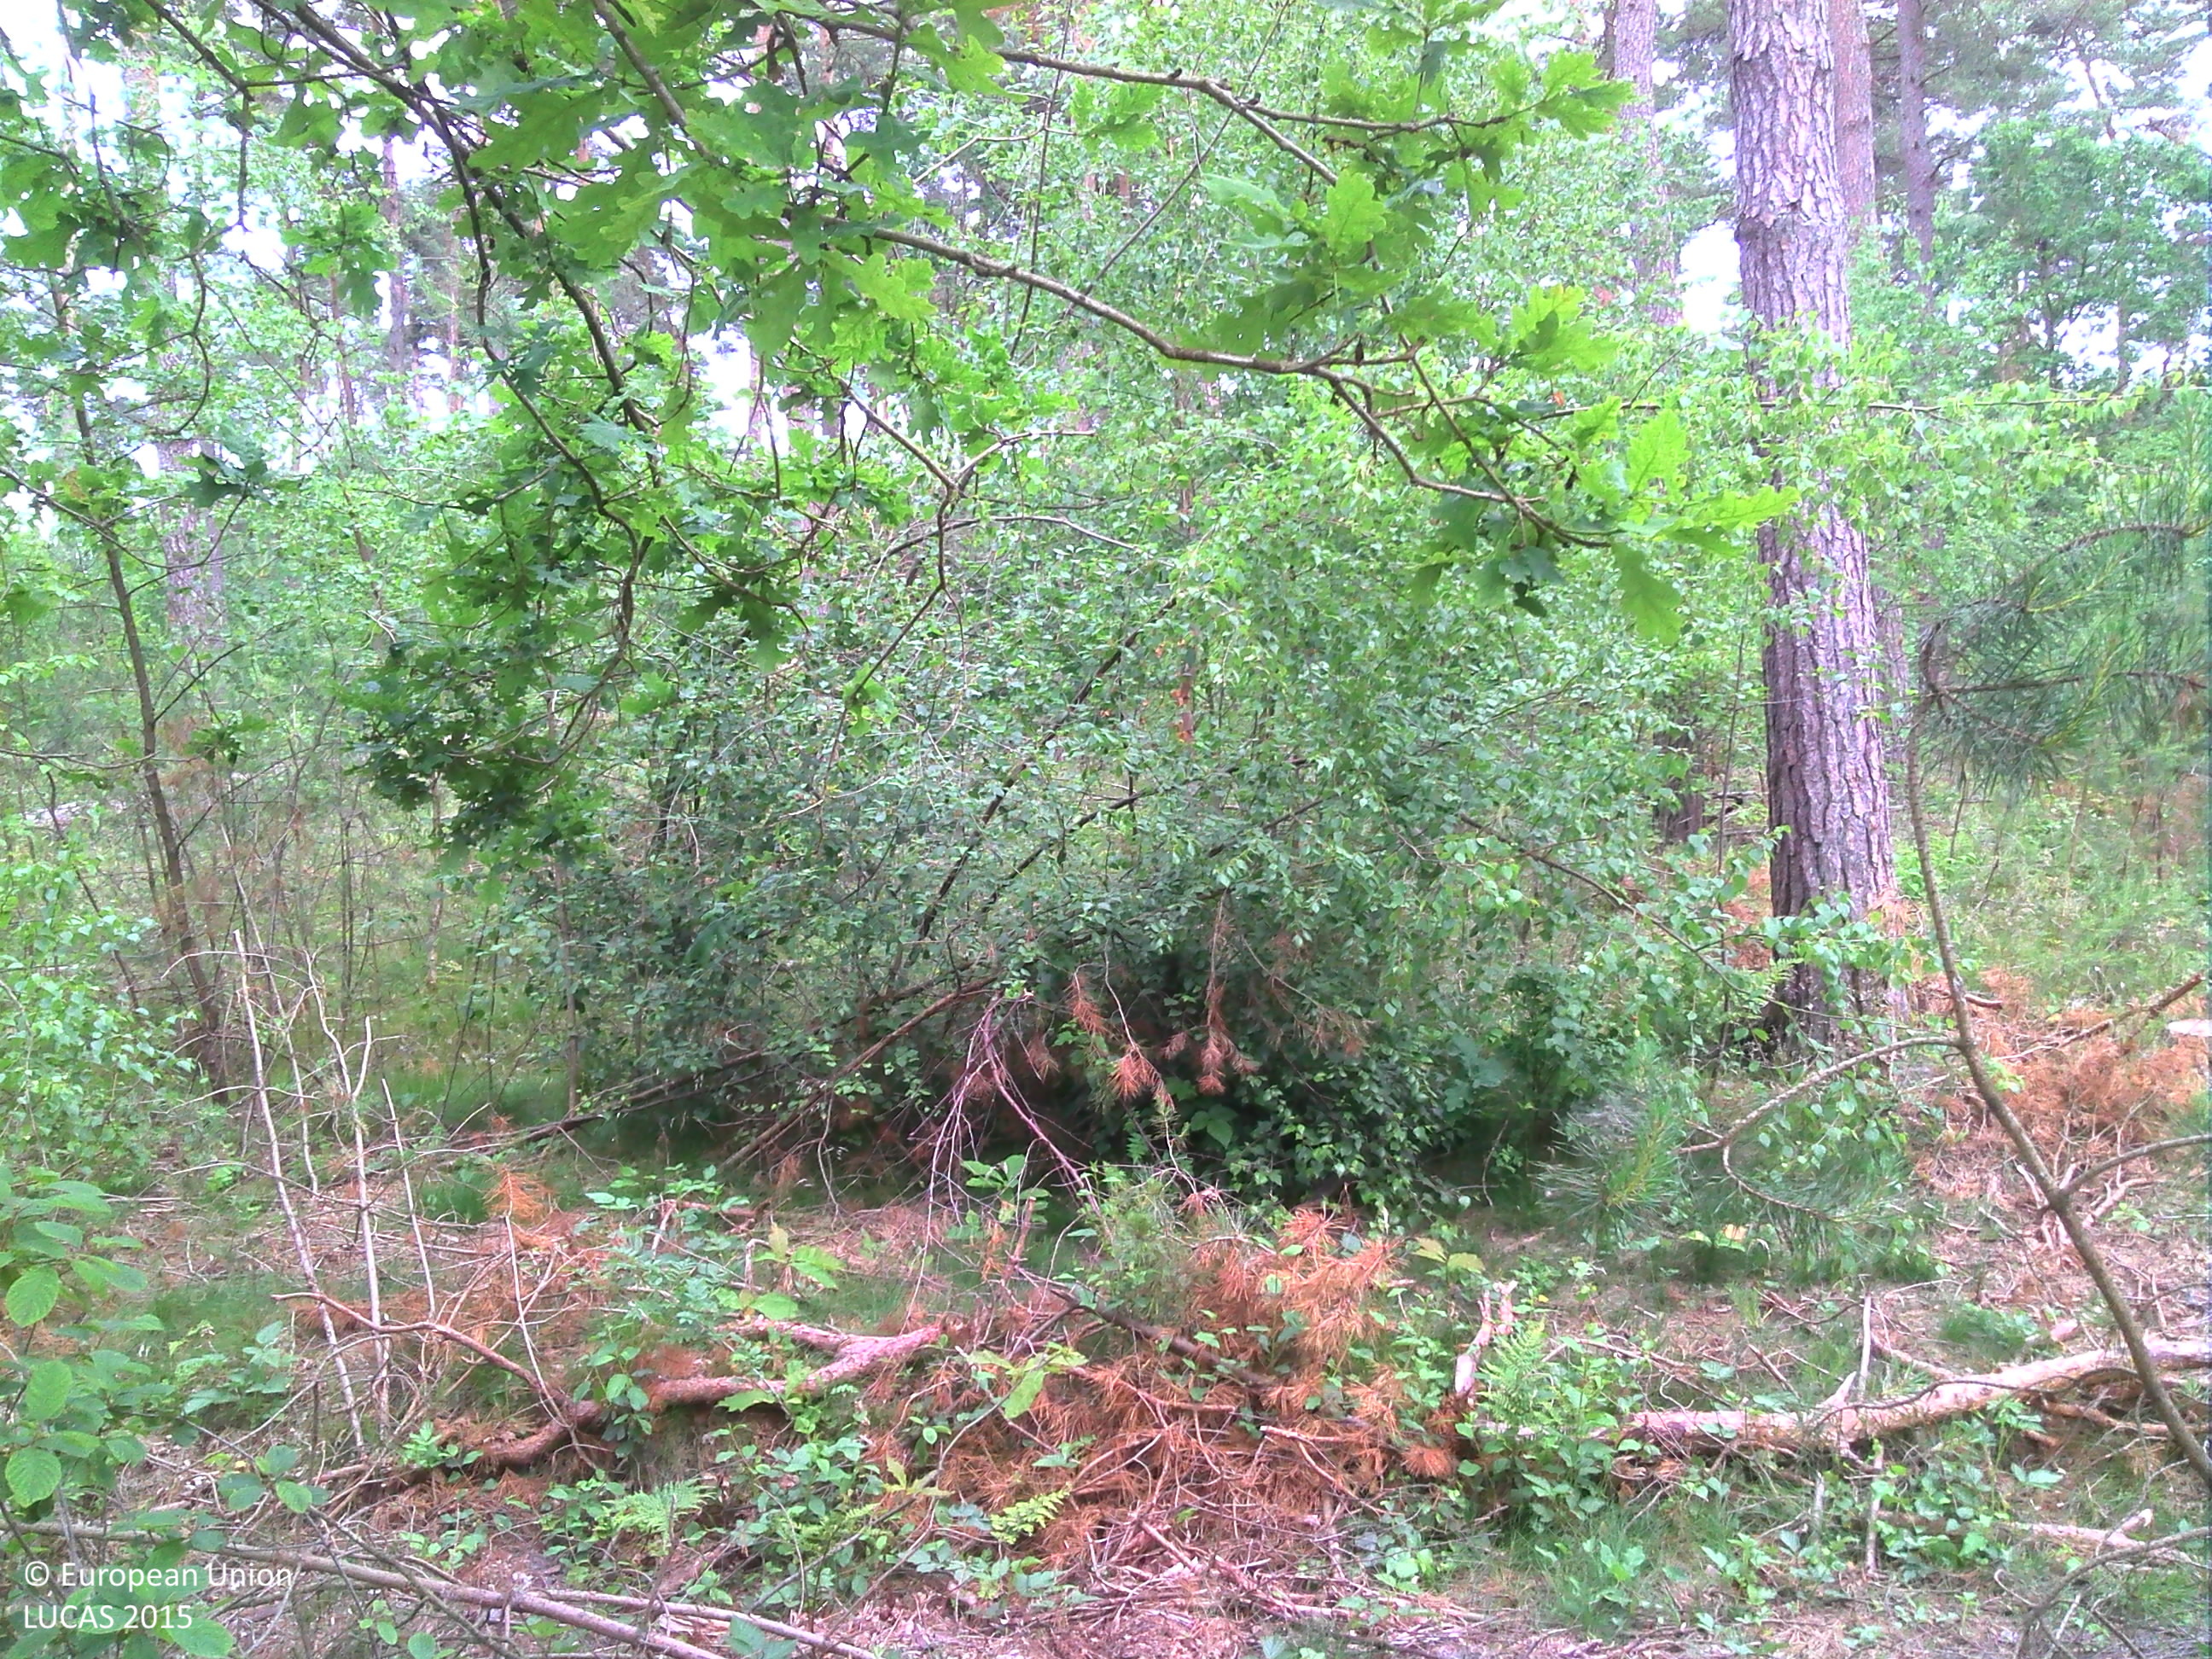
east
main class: Woodland
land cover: Pine dominated mixed woodland
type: exotic forest
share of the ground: > 75 %
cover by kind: coniferous forest trees 75 %, broadleaved forest trees 25 %
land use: Forestry
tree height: > 5 m
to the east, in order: Pine dominated mixed woodland; Pine dominated coniferous woodland; Tracks; Pine dominated mixed woodland; Broadleaved woodland
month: June
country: BE
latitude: 51.1283
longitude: 5.2107
